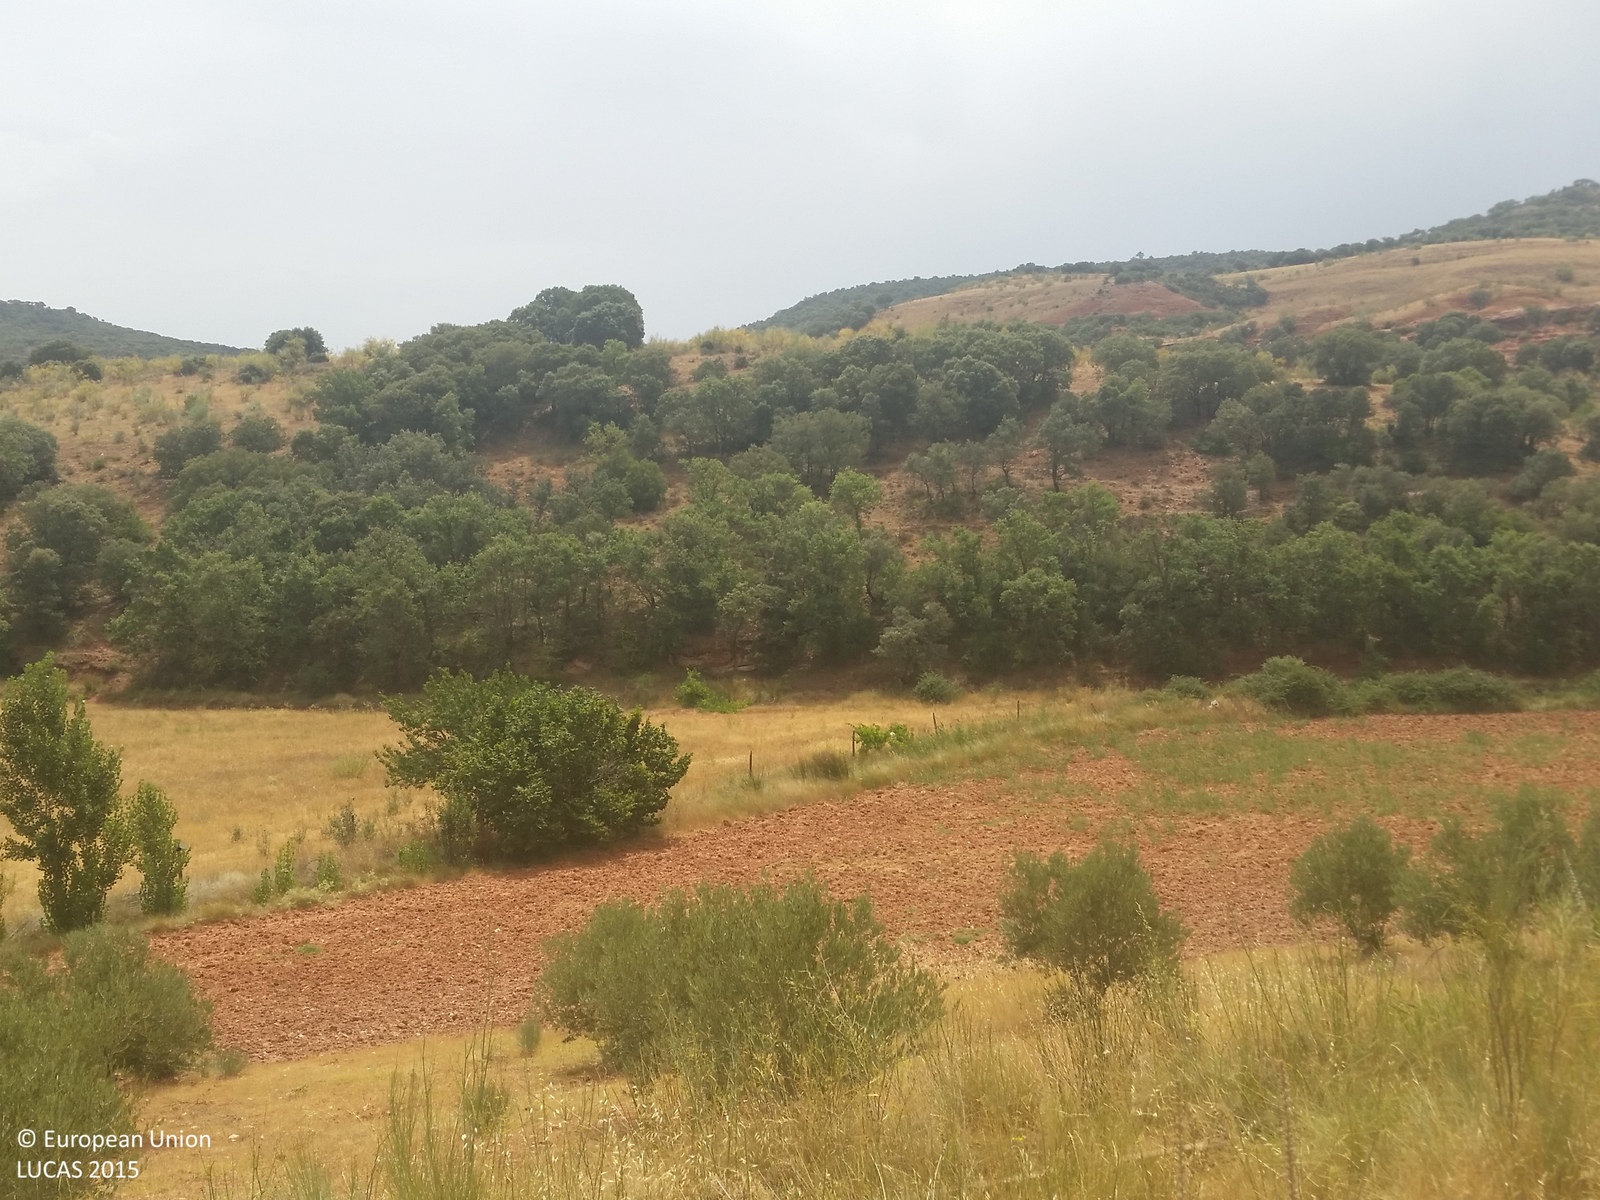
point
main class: Woodland
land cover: Broadleaved woodland
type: acidophilous oak and oak-birch forest
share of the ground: 50 - 75 %
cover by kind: broadleaved forest trees 50 %, shrubs 20 %, herbaceous plants 15 %, consolidated bare surface 15 %
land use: Semi-natural and natural areas not in use
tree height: < 5 m
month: August
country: ES
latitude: 38.6812
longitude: -2.4736
